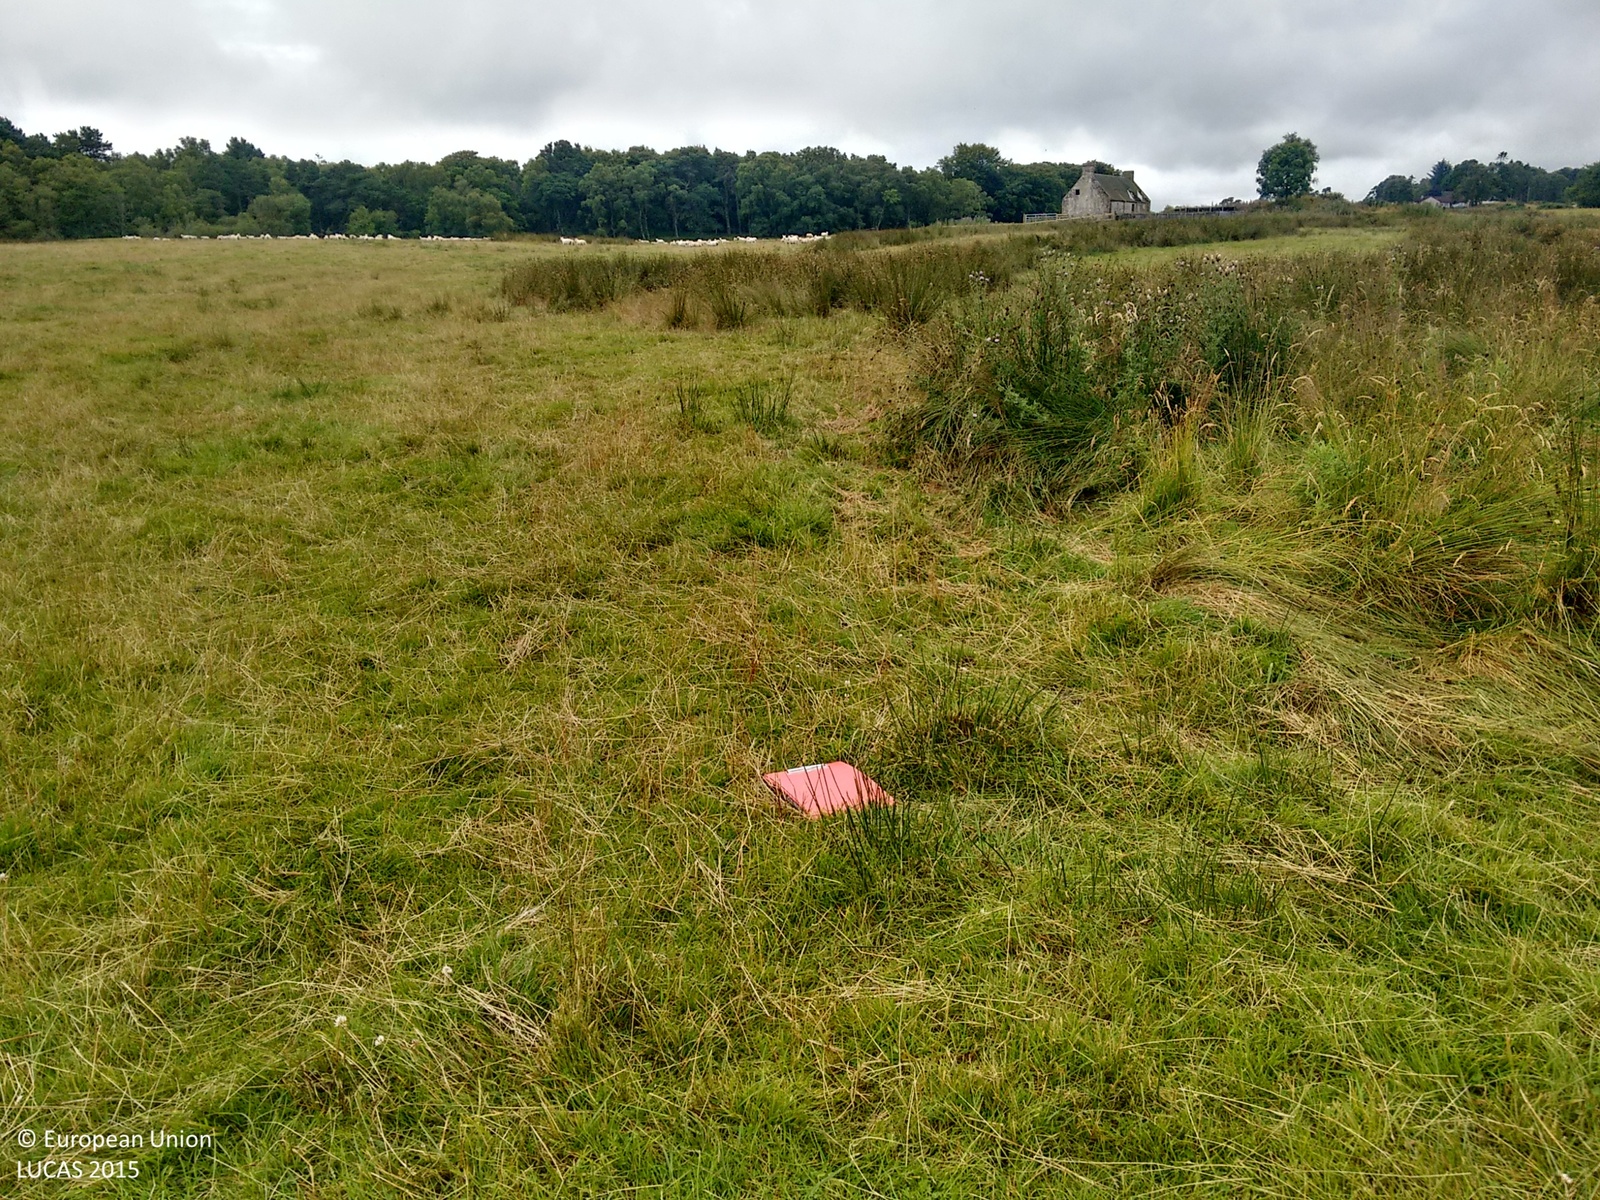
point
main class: Grassland
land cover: Grassland without tree/shrub cover
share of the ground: > 75 %
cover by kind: herbaceous plants 100 %
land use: Agriculture (excluding fallow land and kitchen gardens)
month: August
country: GB
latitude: 57.7867
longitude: -4.0567
